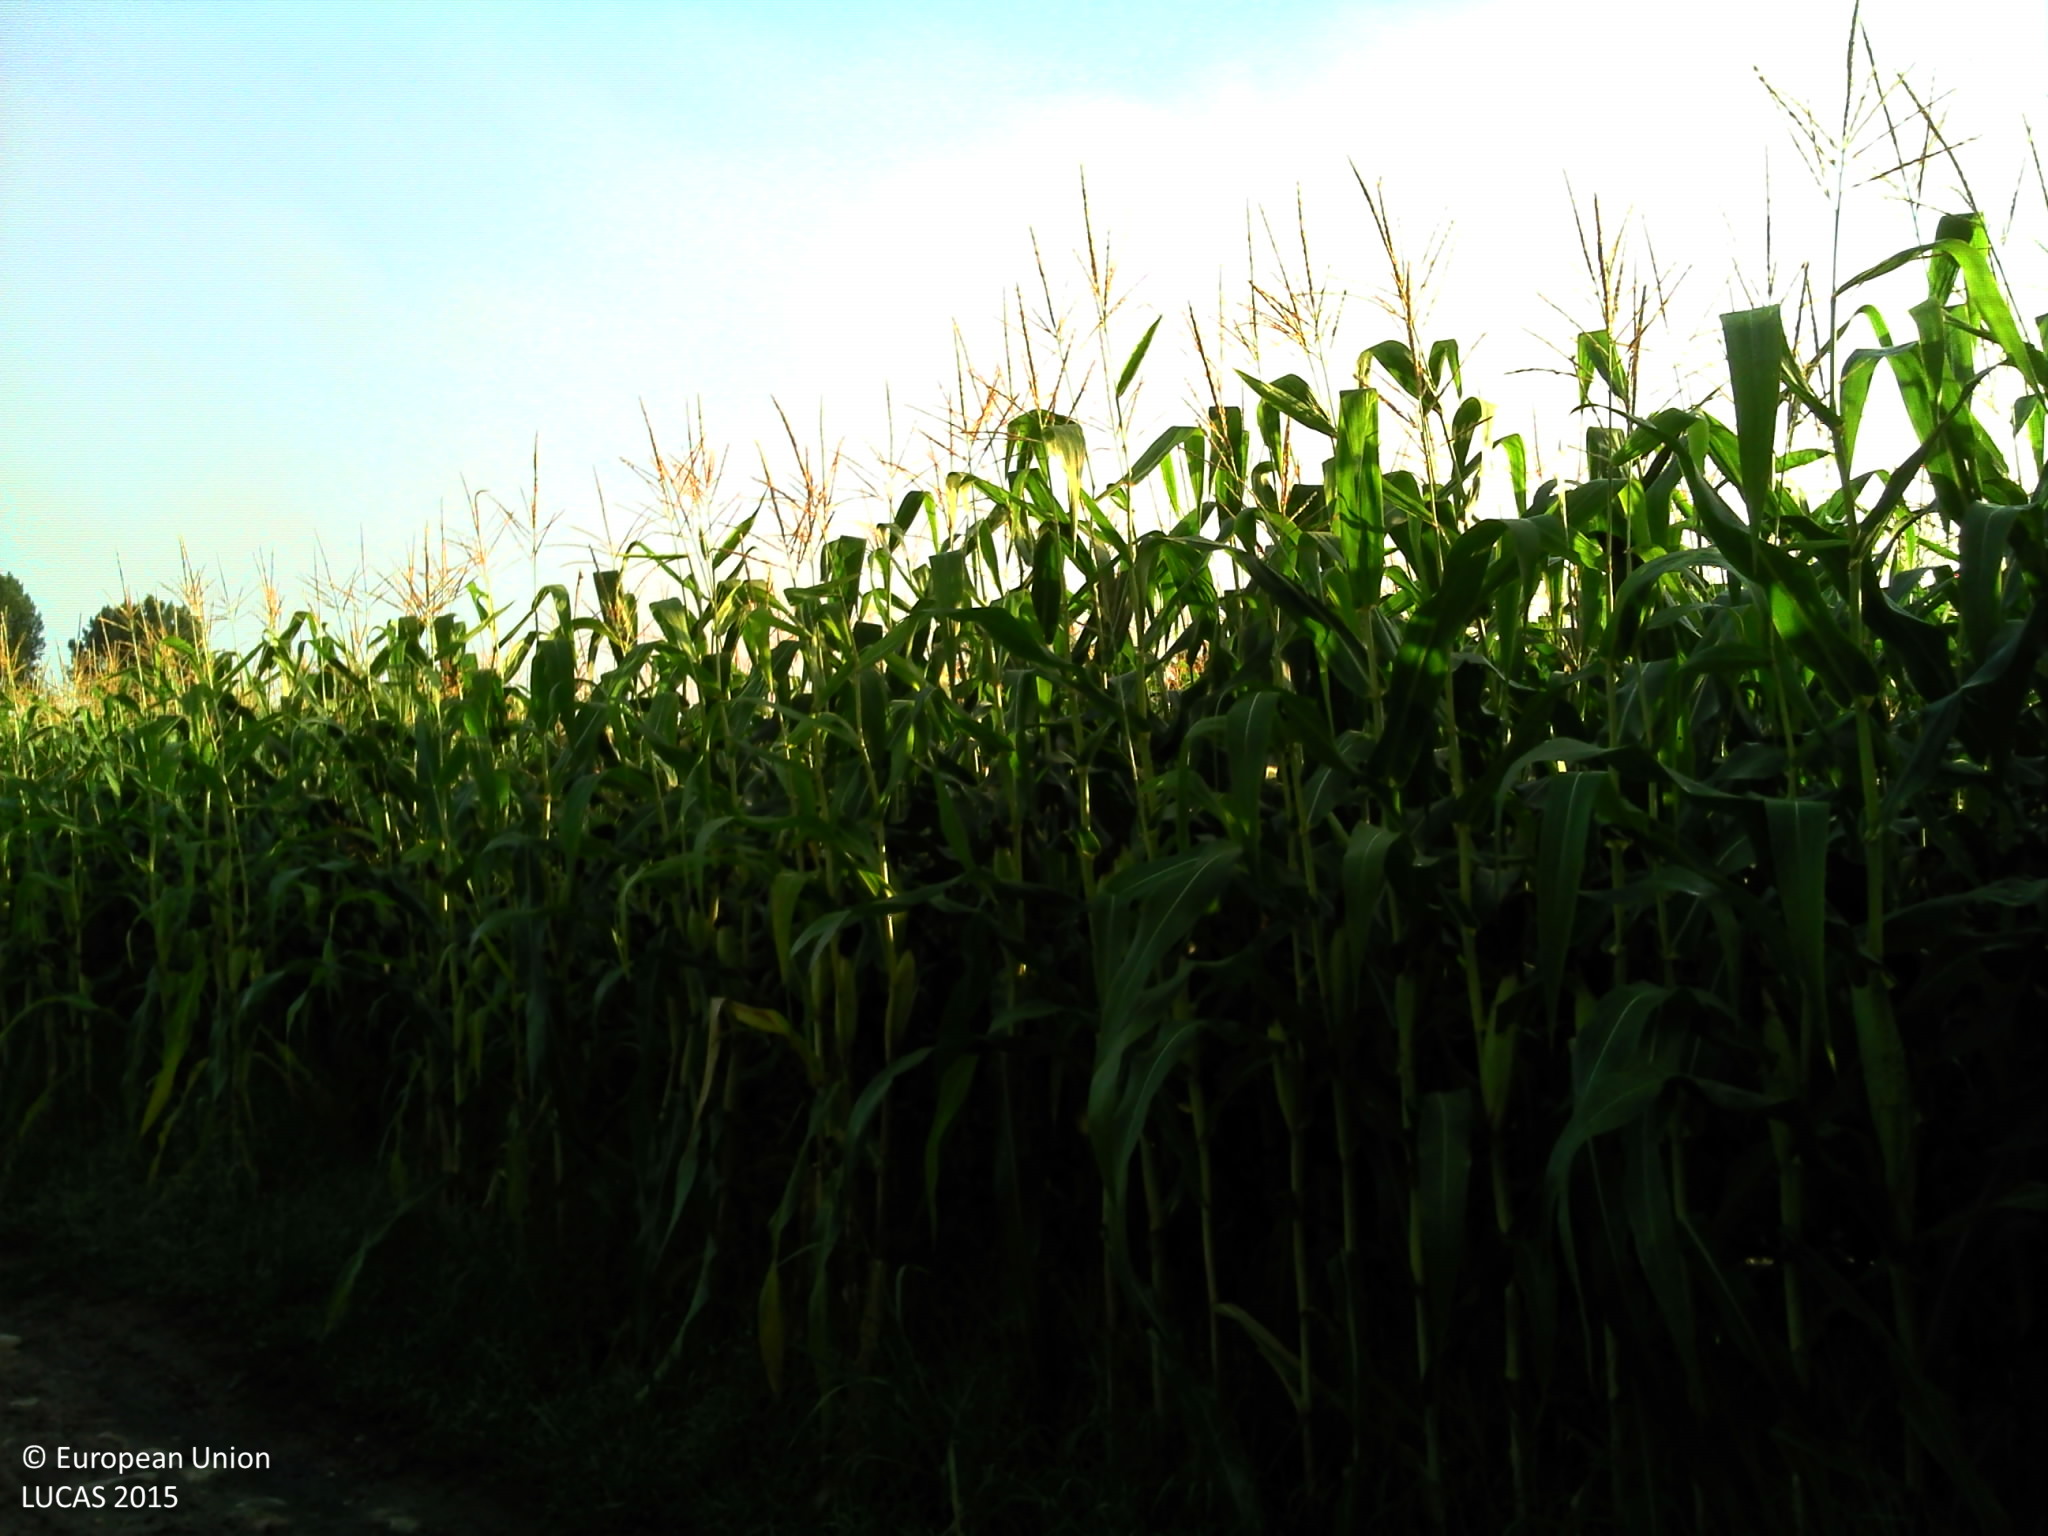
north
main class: Woodland
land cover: Broadleaved woodland
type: thermophilous deciduous forest
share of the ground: > 75 %
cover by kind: broadleaved forest trees 80 %, herbaceous plants 20 %
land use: Forestry
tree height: > 5 m
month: August
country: FR
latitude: 44.8250
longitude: 0.9505
